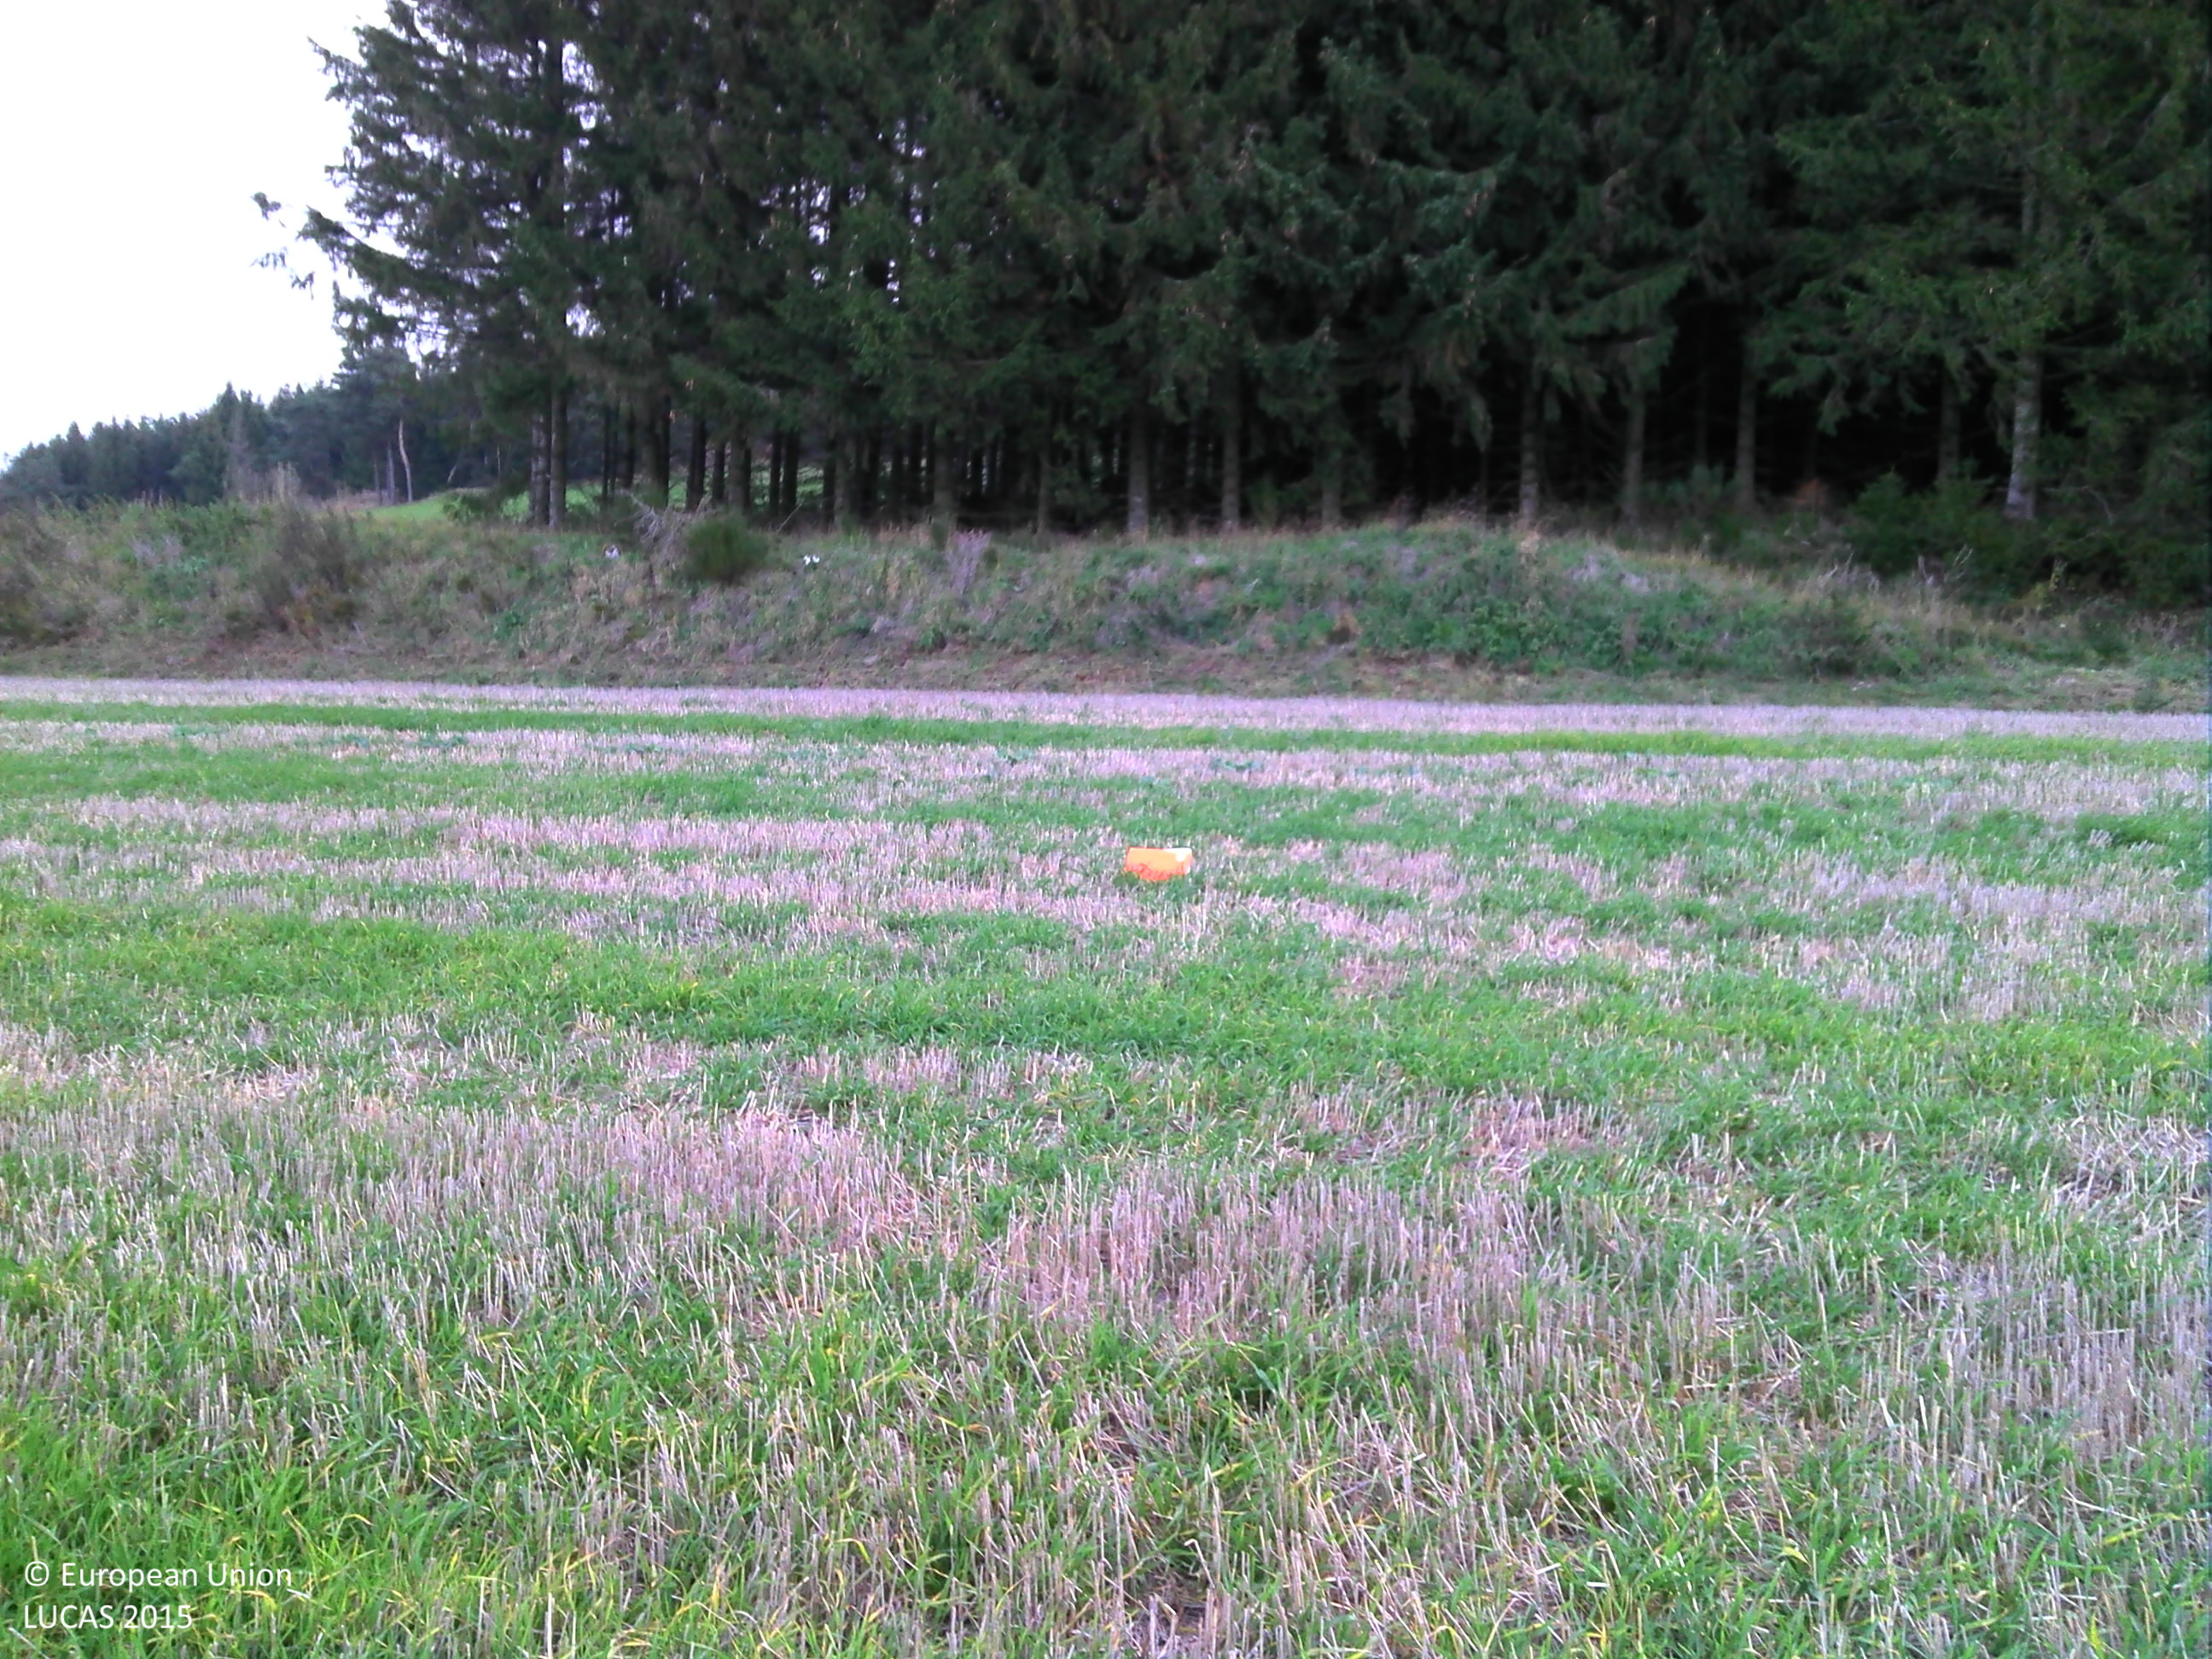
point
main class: Cropland
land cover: Common wheat
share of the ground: 50 - 75 %
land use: Agriculture (excluding fallow land and kitchen gardens)
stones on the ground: < 10 %
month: October
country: FR
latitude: 44.8368
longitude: 3.8442
